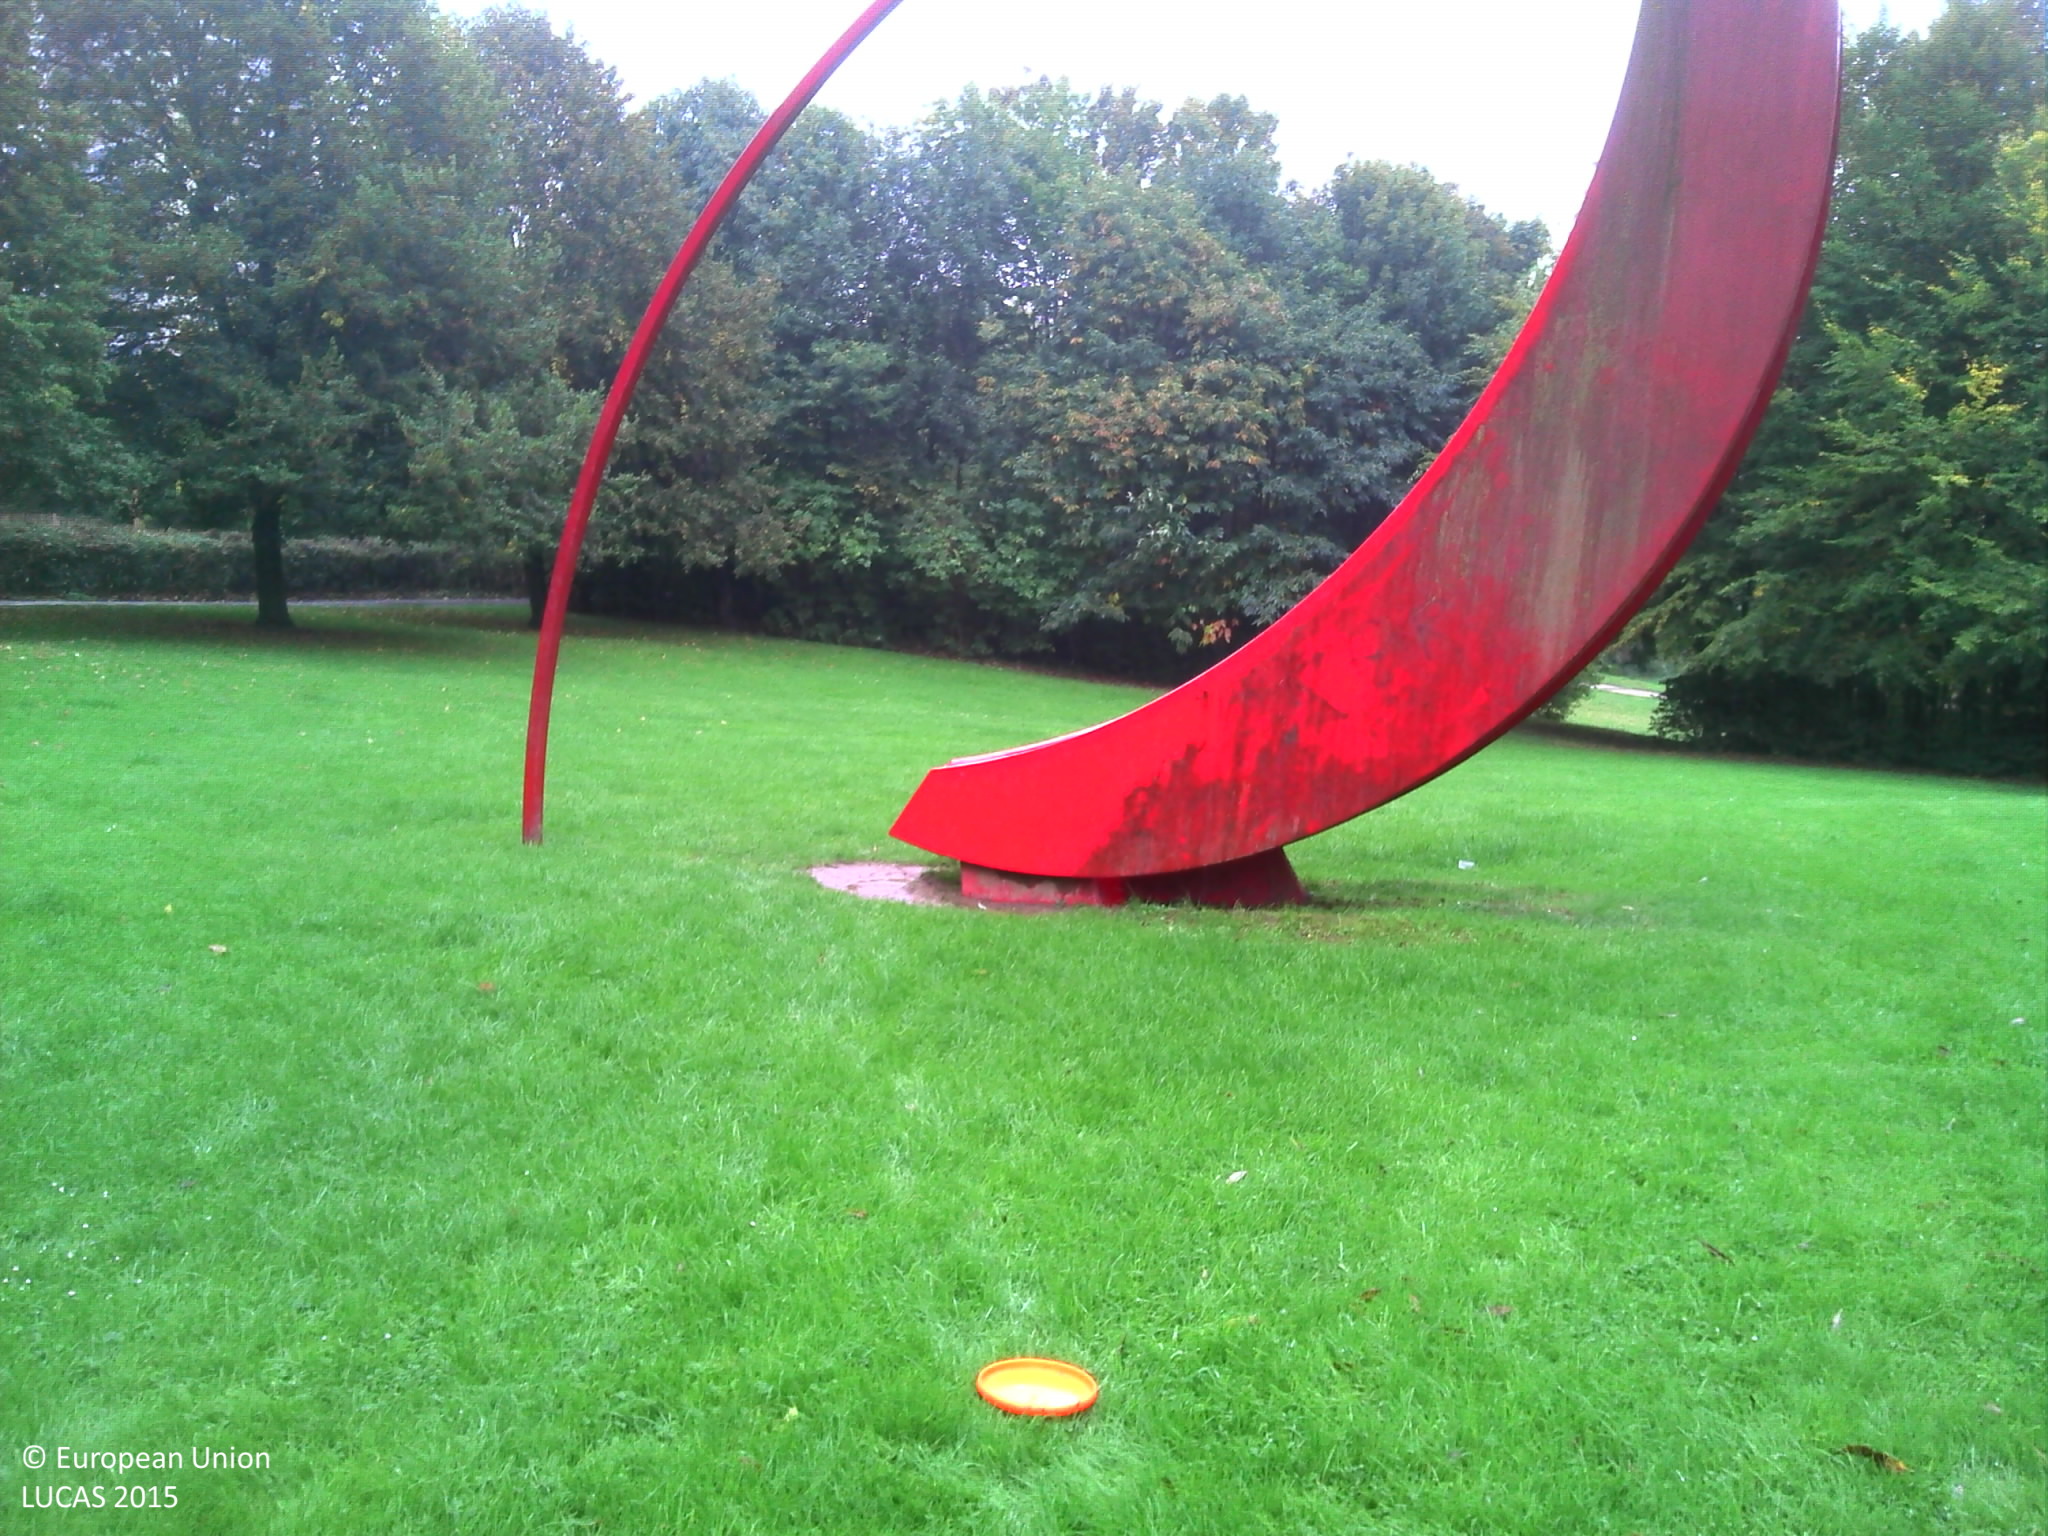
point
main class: Grassland
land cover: Grassland without tree/shrub cover
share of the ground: > 75 %
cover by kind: herbaceous plants 100 %
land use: Amenities, museums, leisure
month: October
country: BE
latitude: 50.8528
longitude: 4.2991
